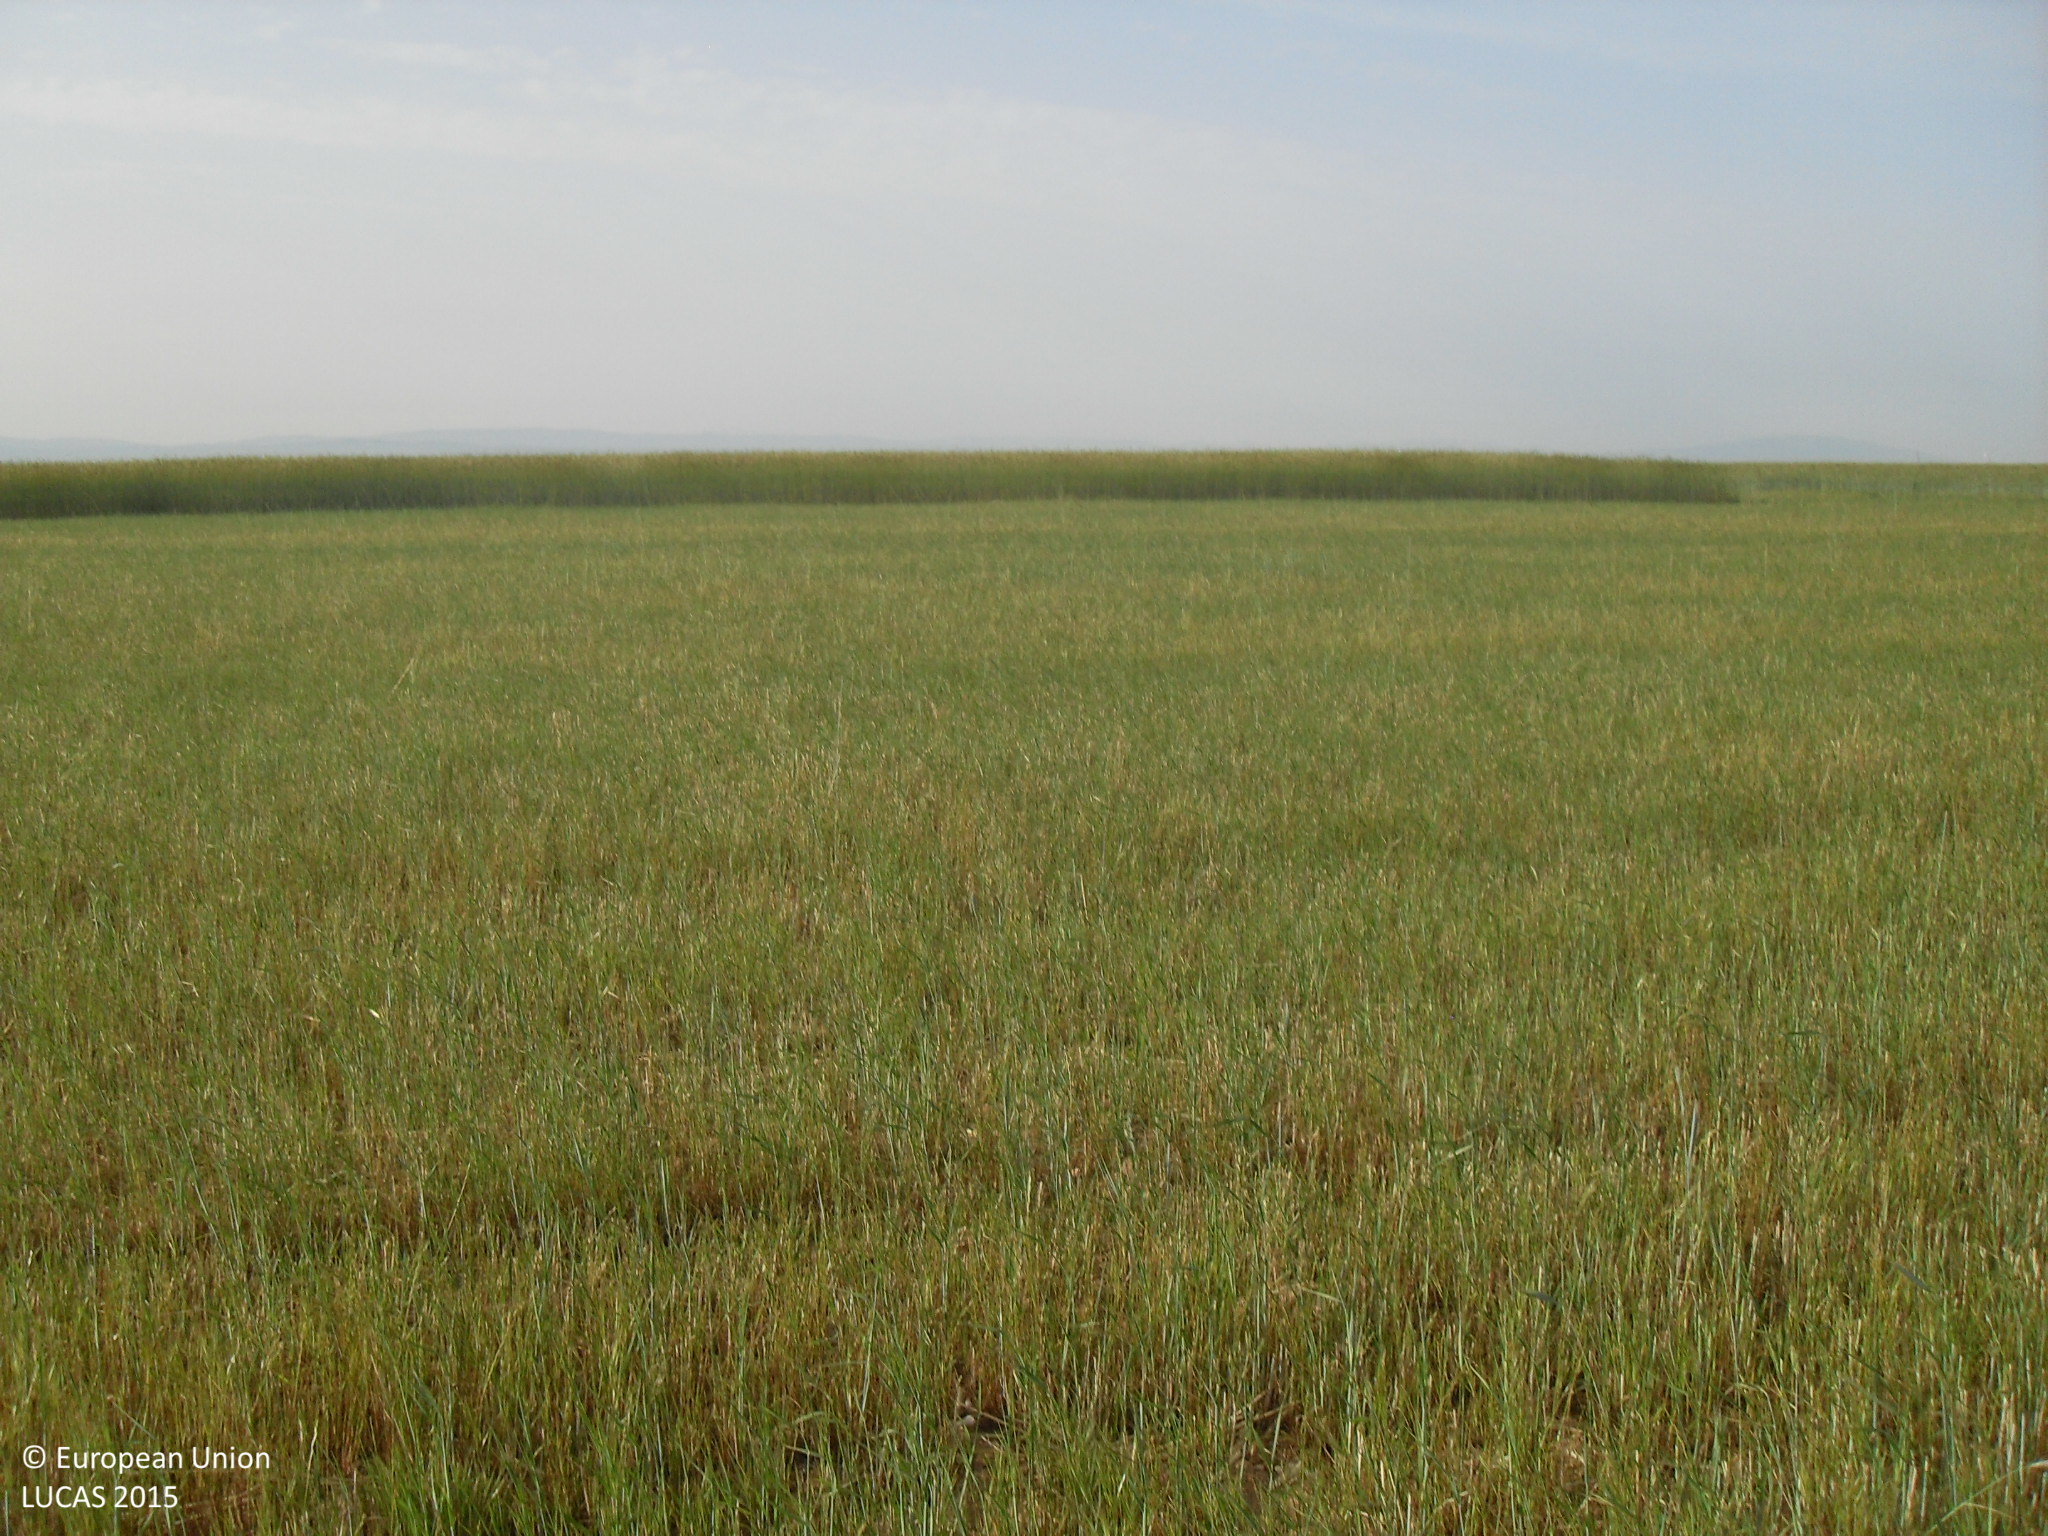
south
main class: Cropland
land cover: Mixed cereals for fodder
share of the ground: > 75 %
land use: Agriculture (excluding fallow land and kitchen gardens)
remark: Harvested field
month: May
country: ES
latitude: 40.9599
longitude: -5.3626
